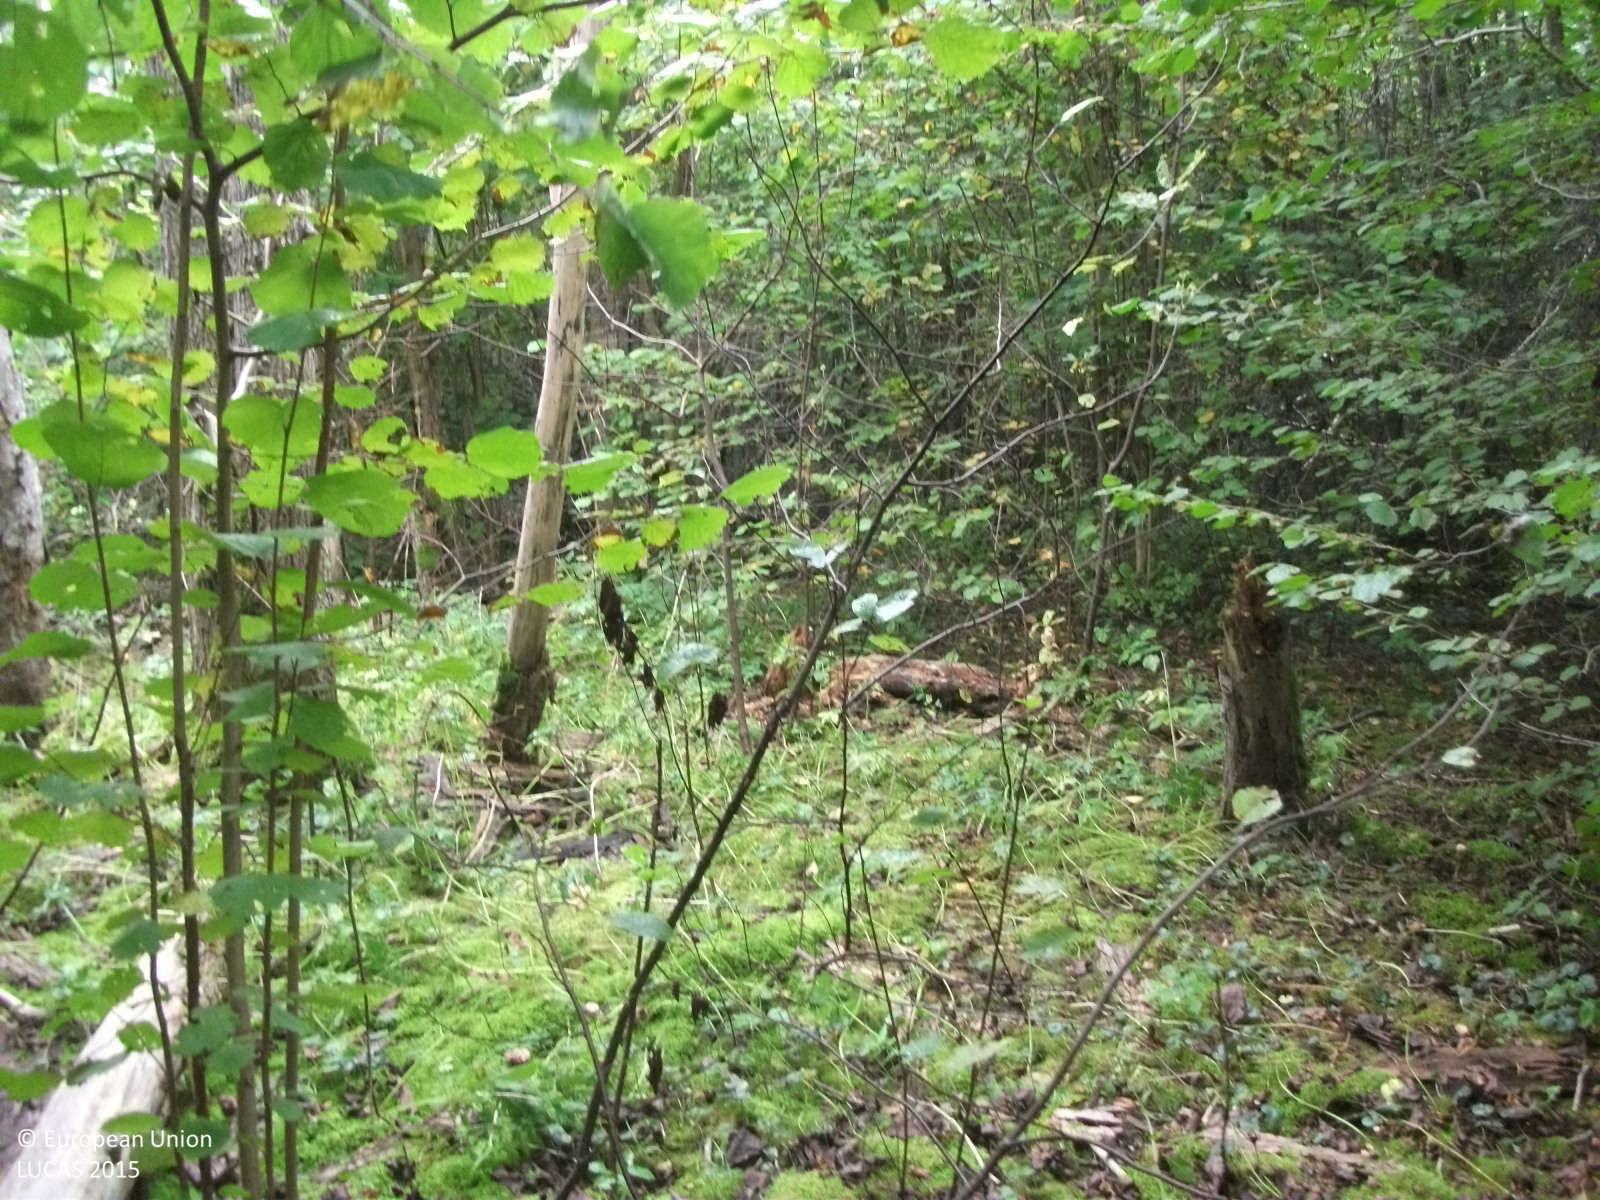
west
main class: Woodland
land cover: Broadleaved woodland
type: floodplain forest
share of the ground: 50 - 75 %
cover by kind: broadleaved forest trees 70 %, herbaceous plants 10 %, shrubs 5 %, lichens and mosses 5 %, unconsolidated bare surface 5 %
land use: Semi-natural and natural areas not in use
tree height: > 5 m
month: September
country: LV
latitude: 57.7614
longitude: 24.4592
